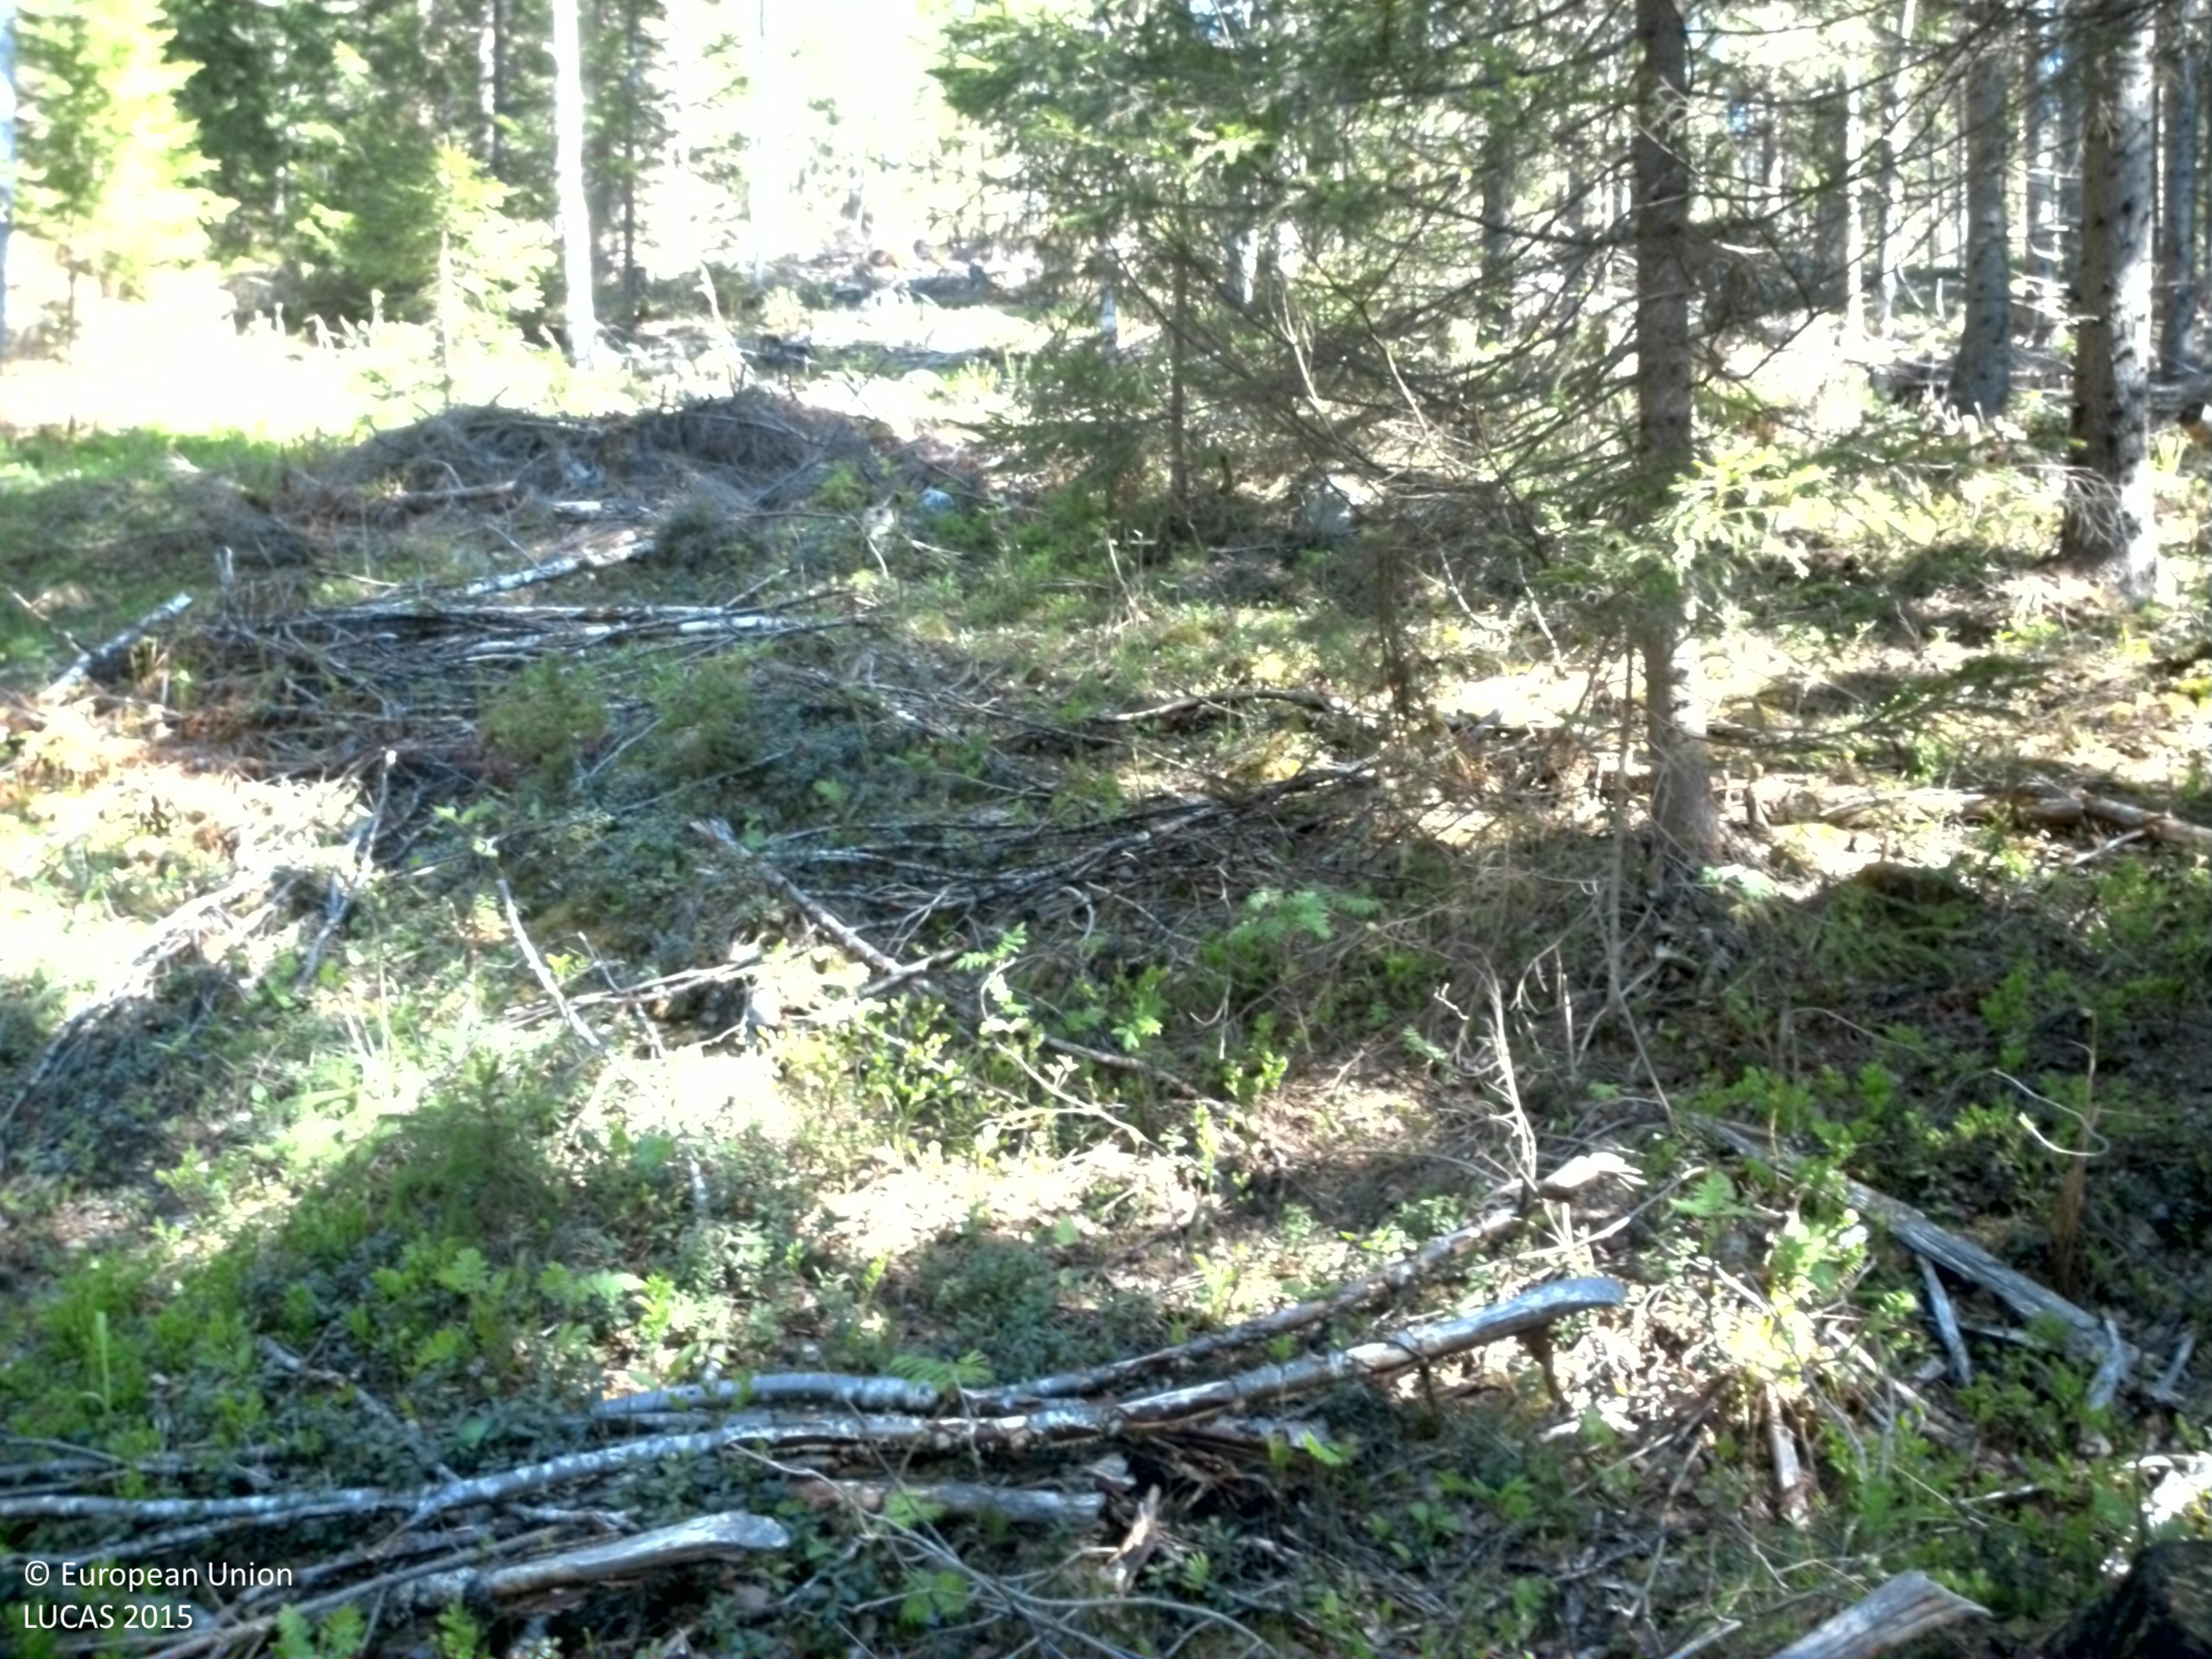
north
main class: Woodland
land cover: Spruce dominated coniferous woodland
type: boreal forest
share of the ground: 25 - 50 %
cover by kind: coniferous forest trees 50 %, shrubs 20 %, lichens and mosses 10 %
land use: Forestry
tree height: > 5 m
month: May
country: SE
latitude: 63.0015
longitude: 17.9351
